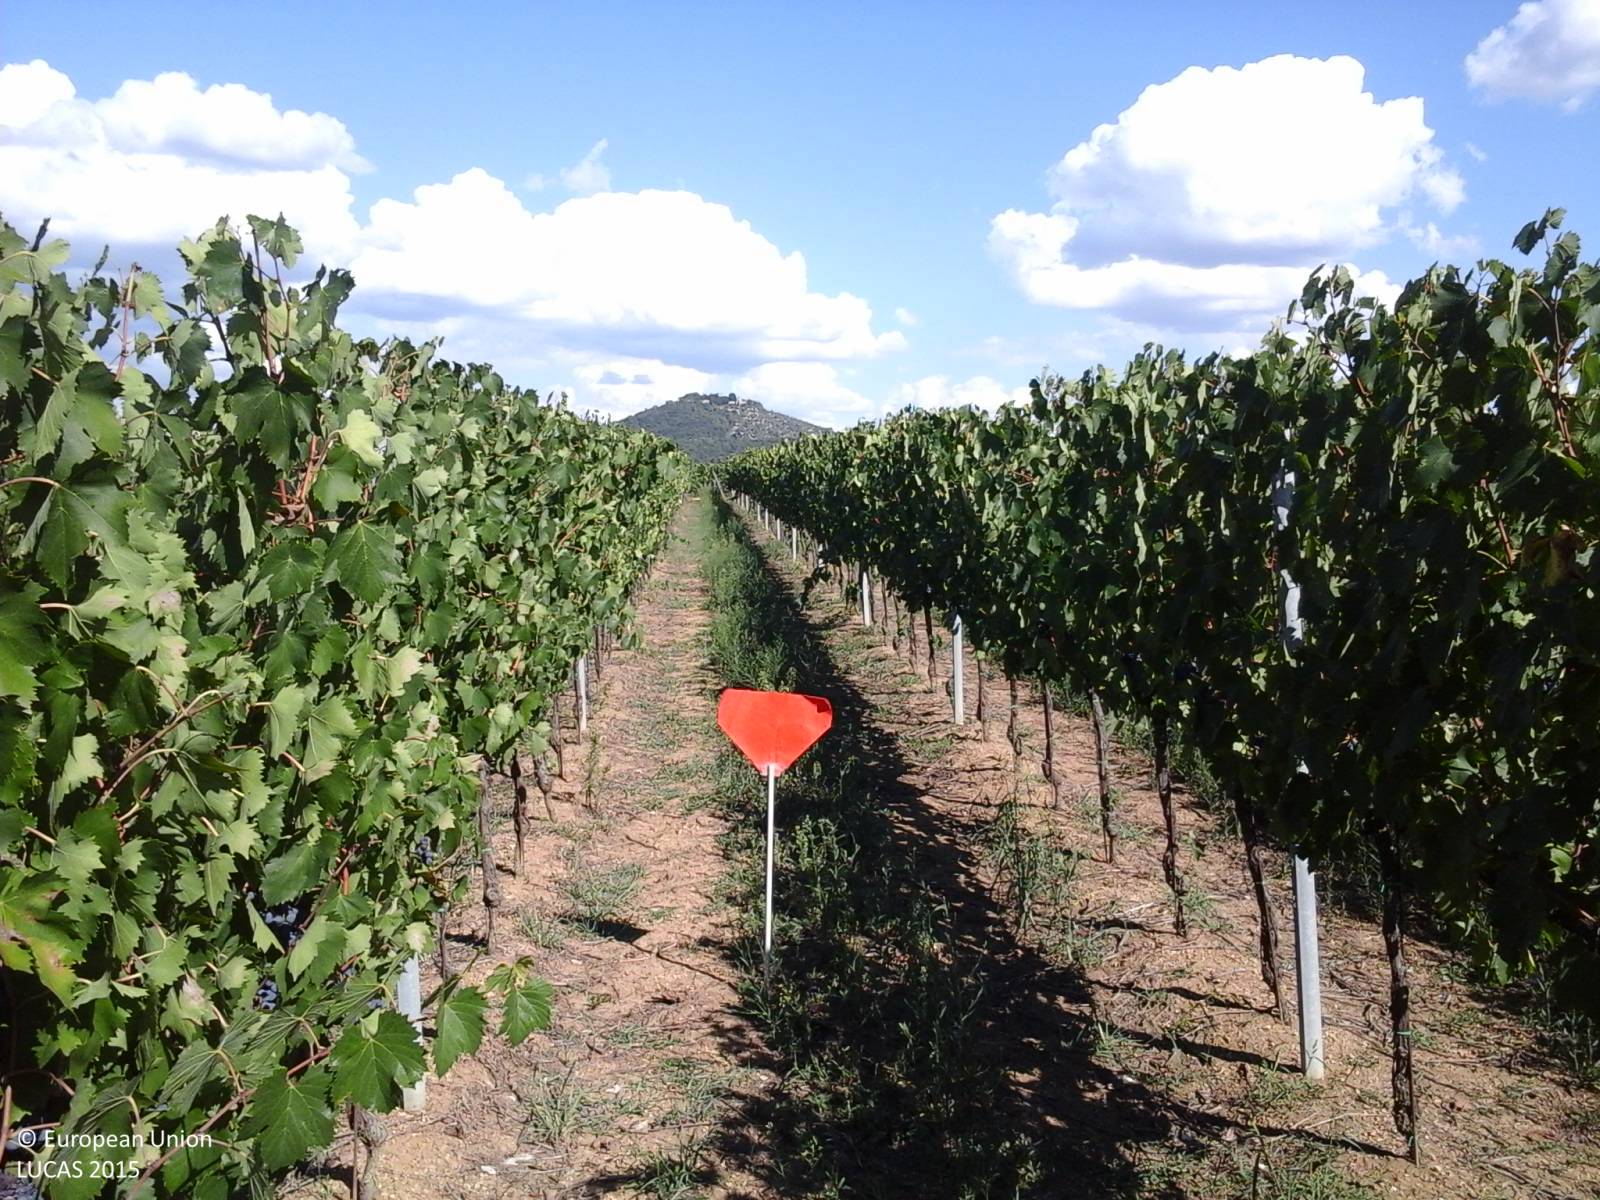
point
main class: Cropland
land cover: Vineyards
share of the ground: 25 - 50 %
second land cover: Spontaneously vegetated surfaces
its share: > 75 %
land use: Agriculture (excluding fallow land and kitchen gardens)
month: September
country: IT
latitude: 43.0659
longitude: 12.0936
